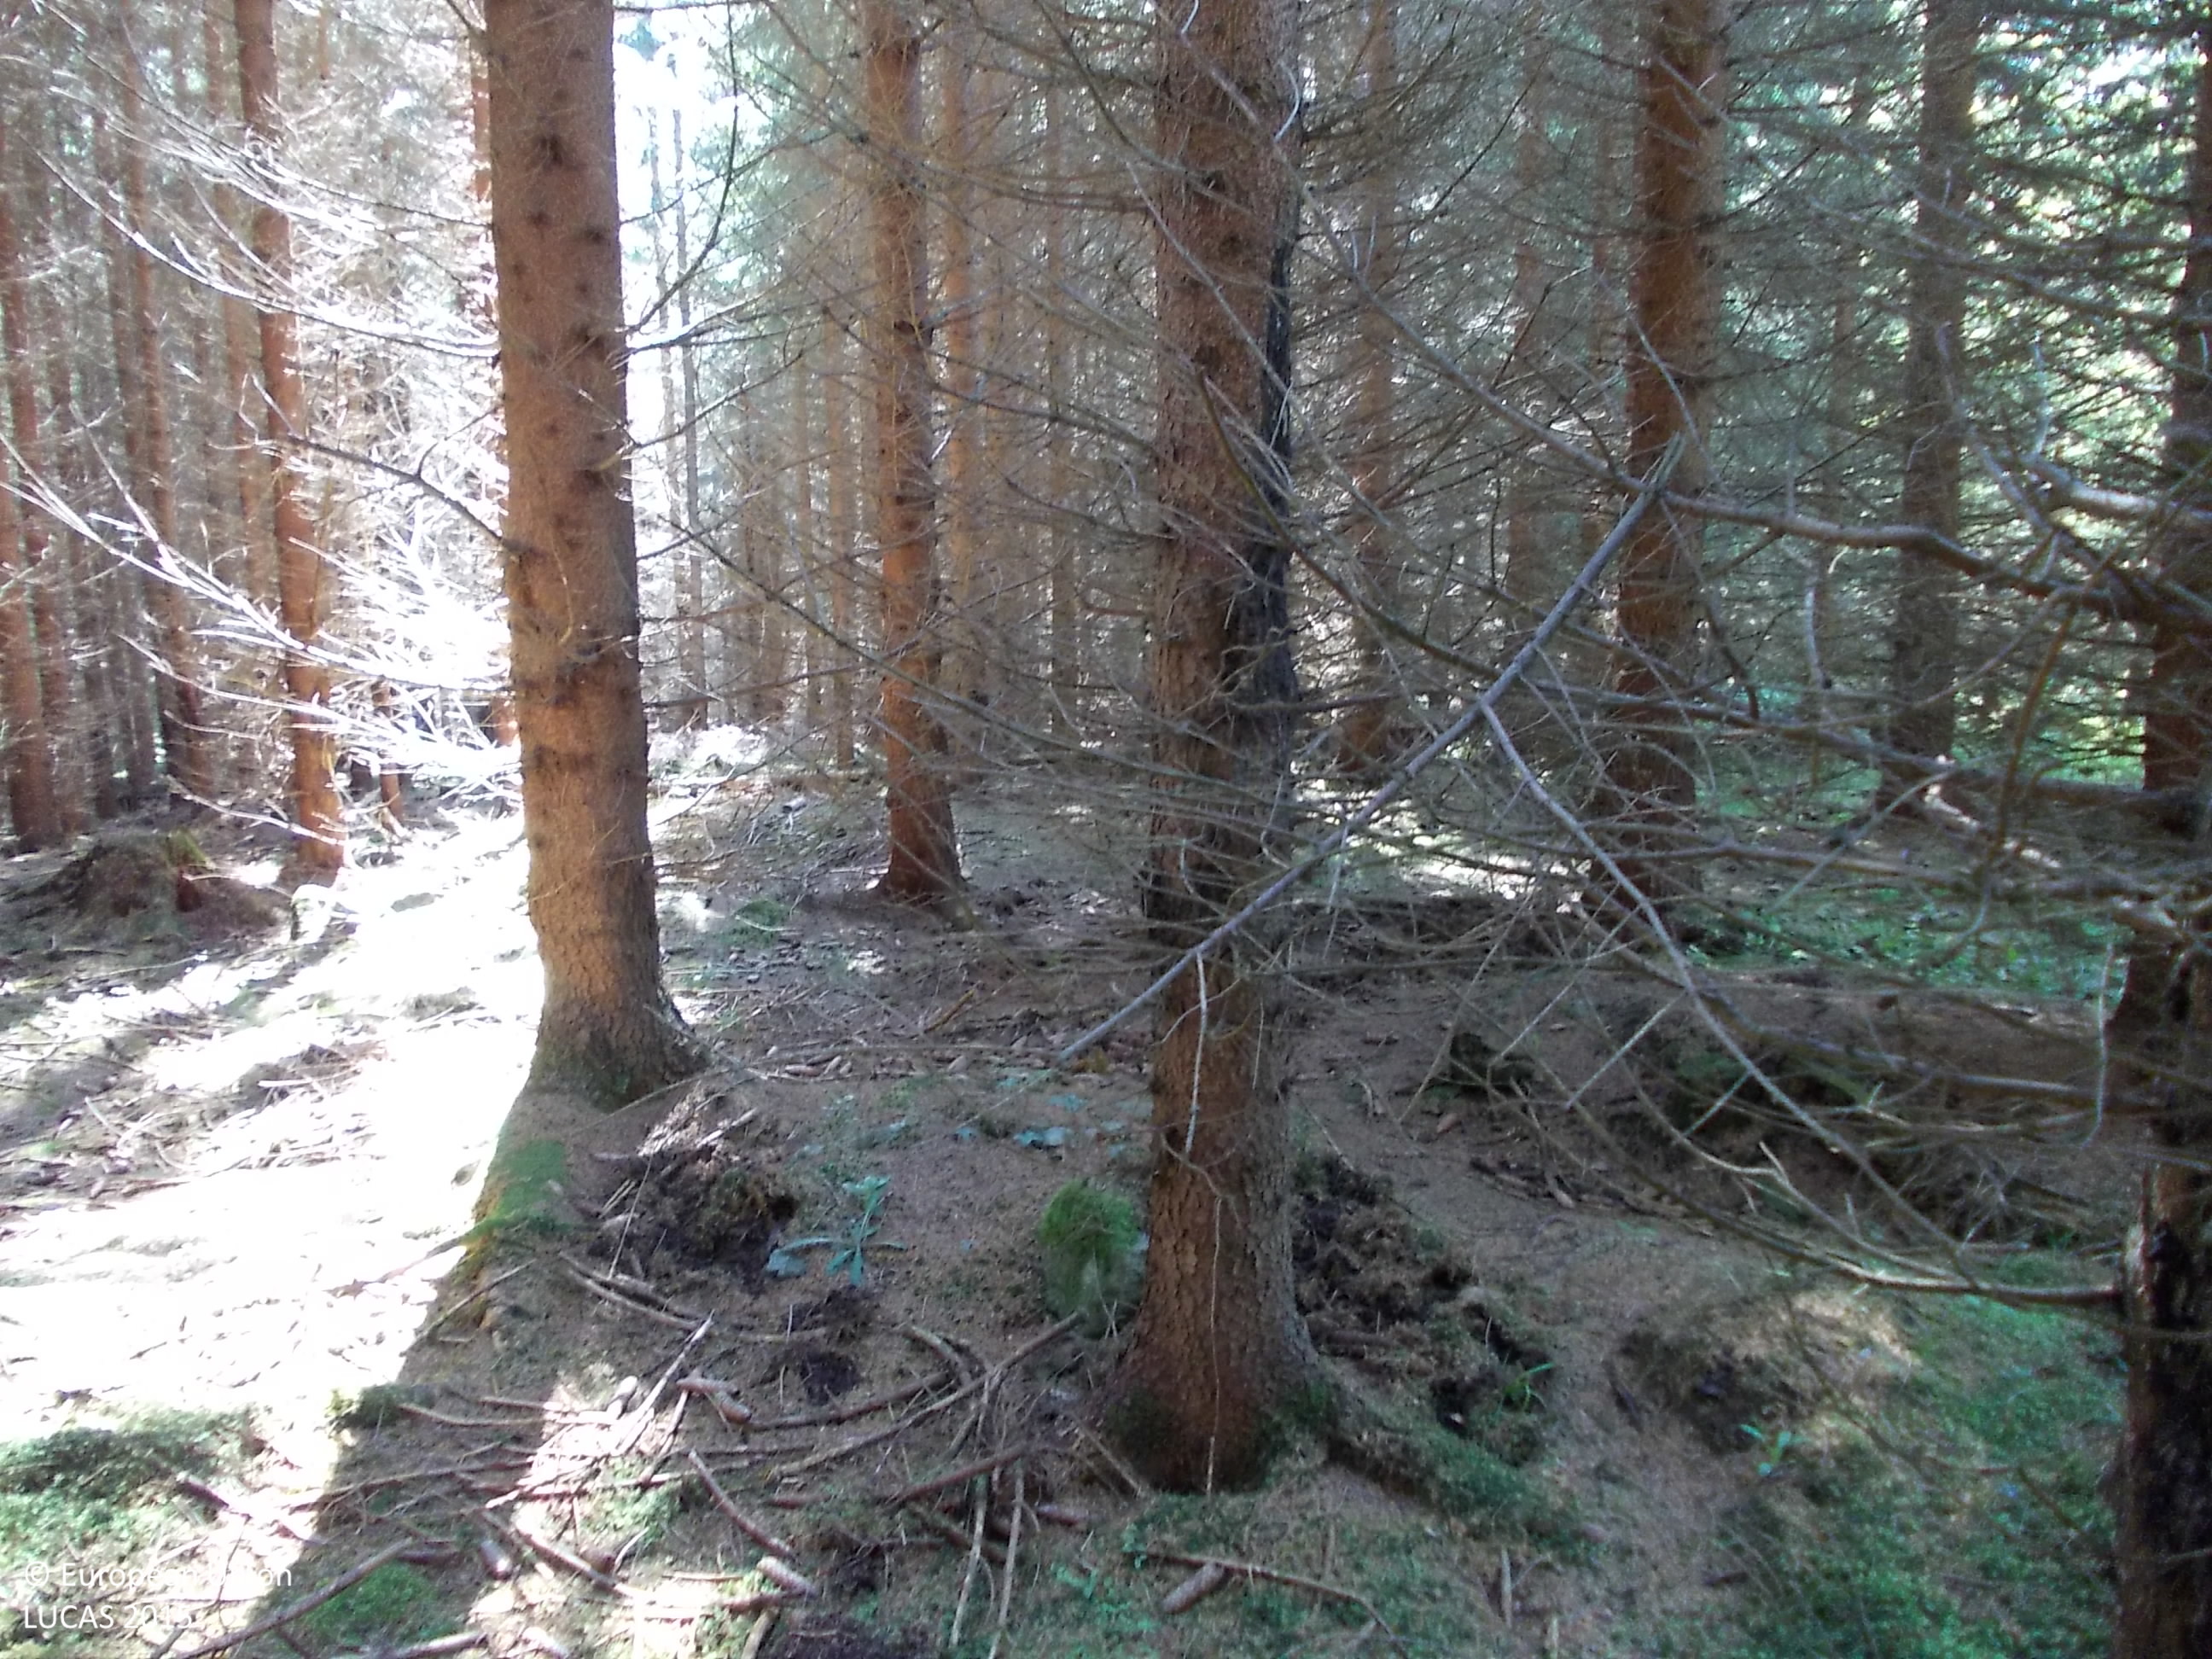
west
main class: Woodland
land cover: Spruce dominated coniferous woodland
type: hemiboreal forest and nemoral coniferous forest and mixed broadleaved-coniferous forest
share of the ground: > 75 %
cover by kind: coniferous forest trees 90 %, lichens and mosses 5 %, consolidated bare surface 5 %
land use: Forestry
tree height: > 5 m
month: June
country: CZ
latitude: 48.9719
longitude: 13.7022
